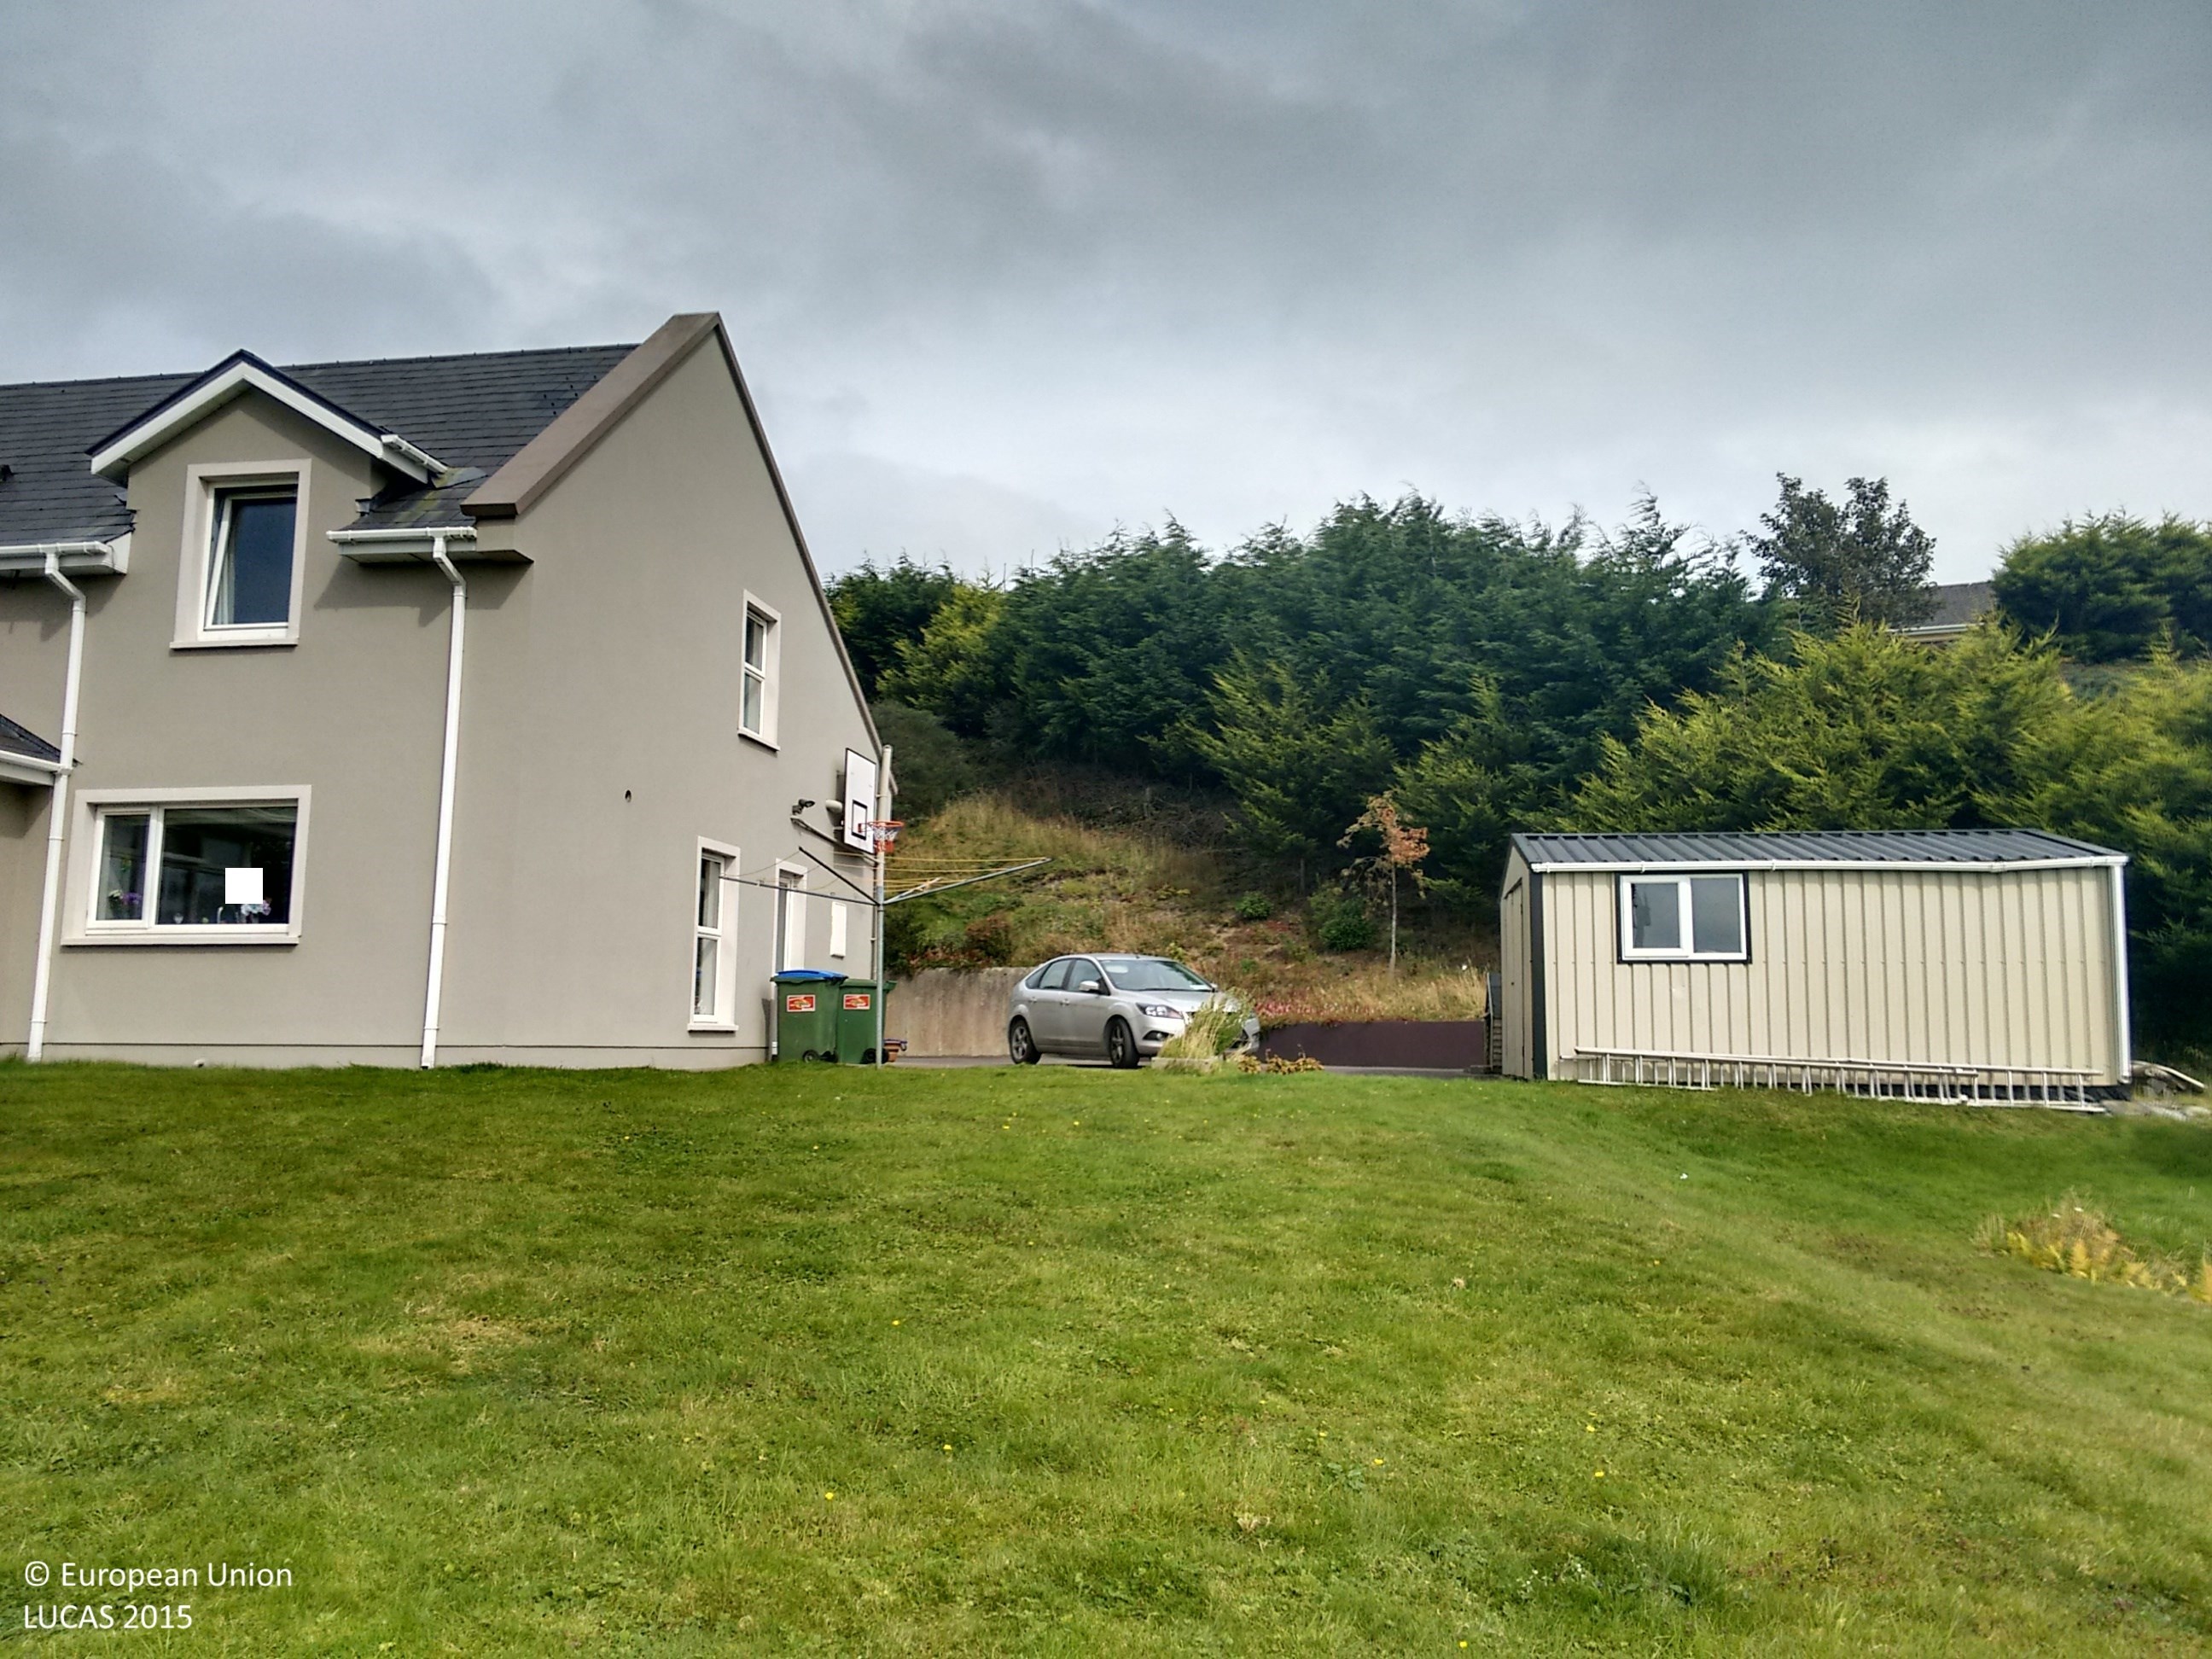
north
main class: Grassland
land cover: Grassland without tree/shrub cover
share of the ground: > 75 %
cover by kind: herbaceous plants 80 %
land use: Residential
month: September
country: IE
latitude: 52.0621
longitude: -9.4404
